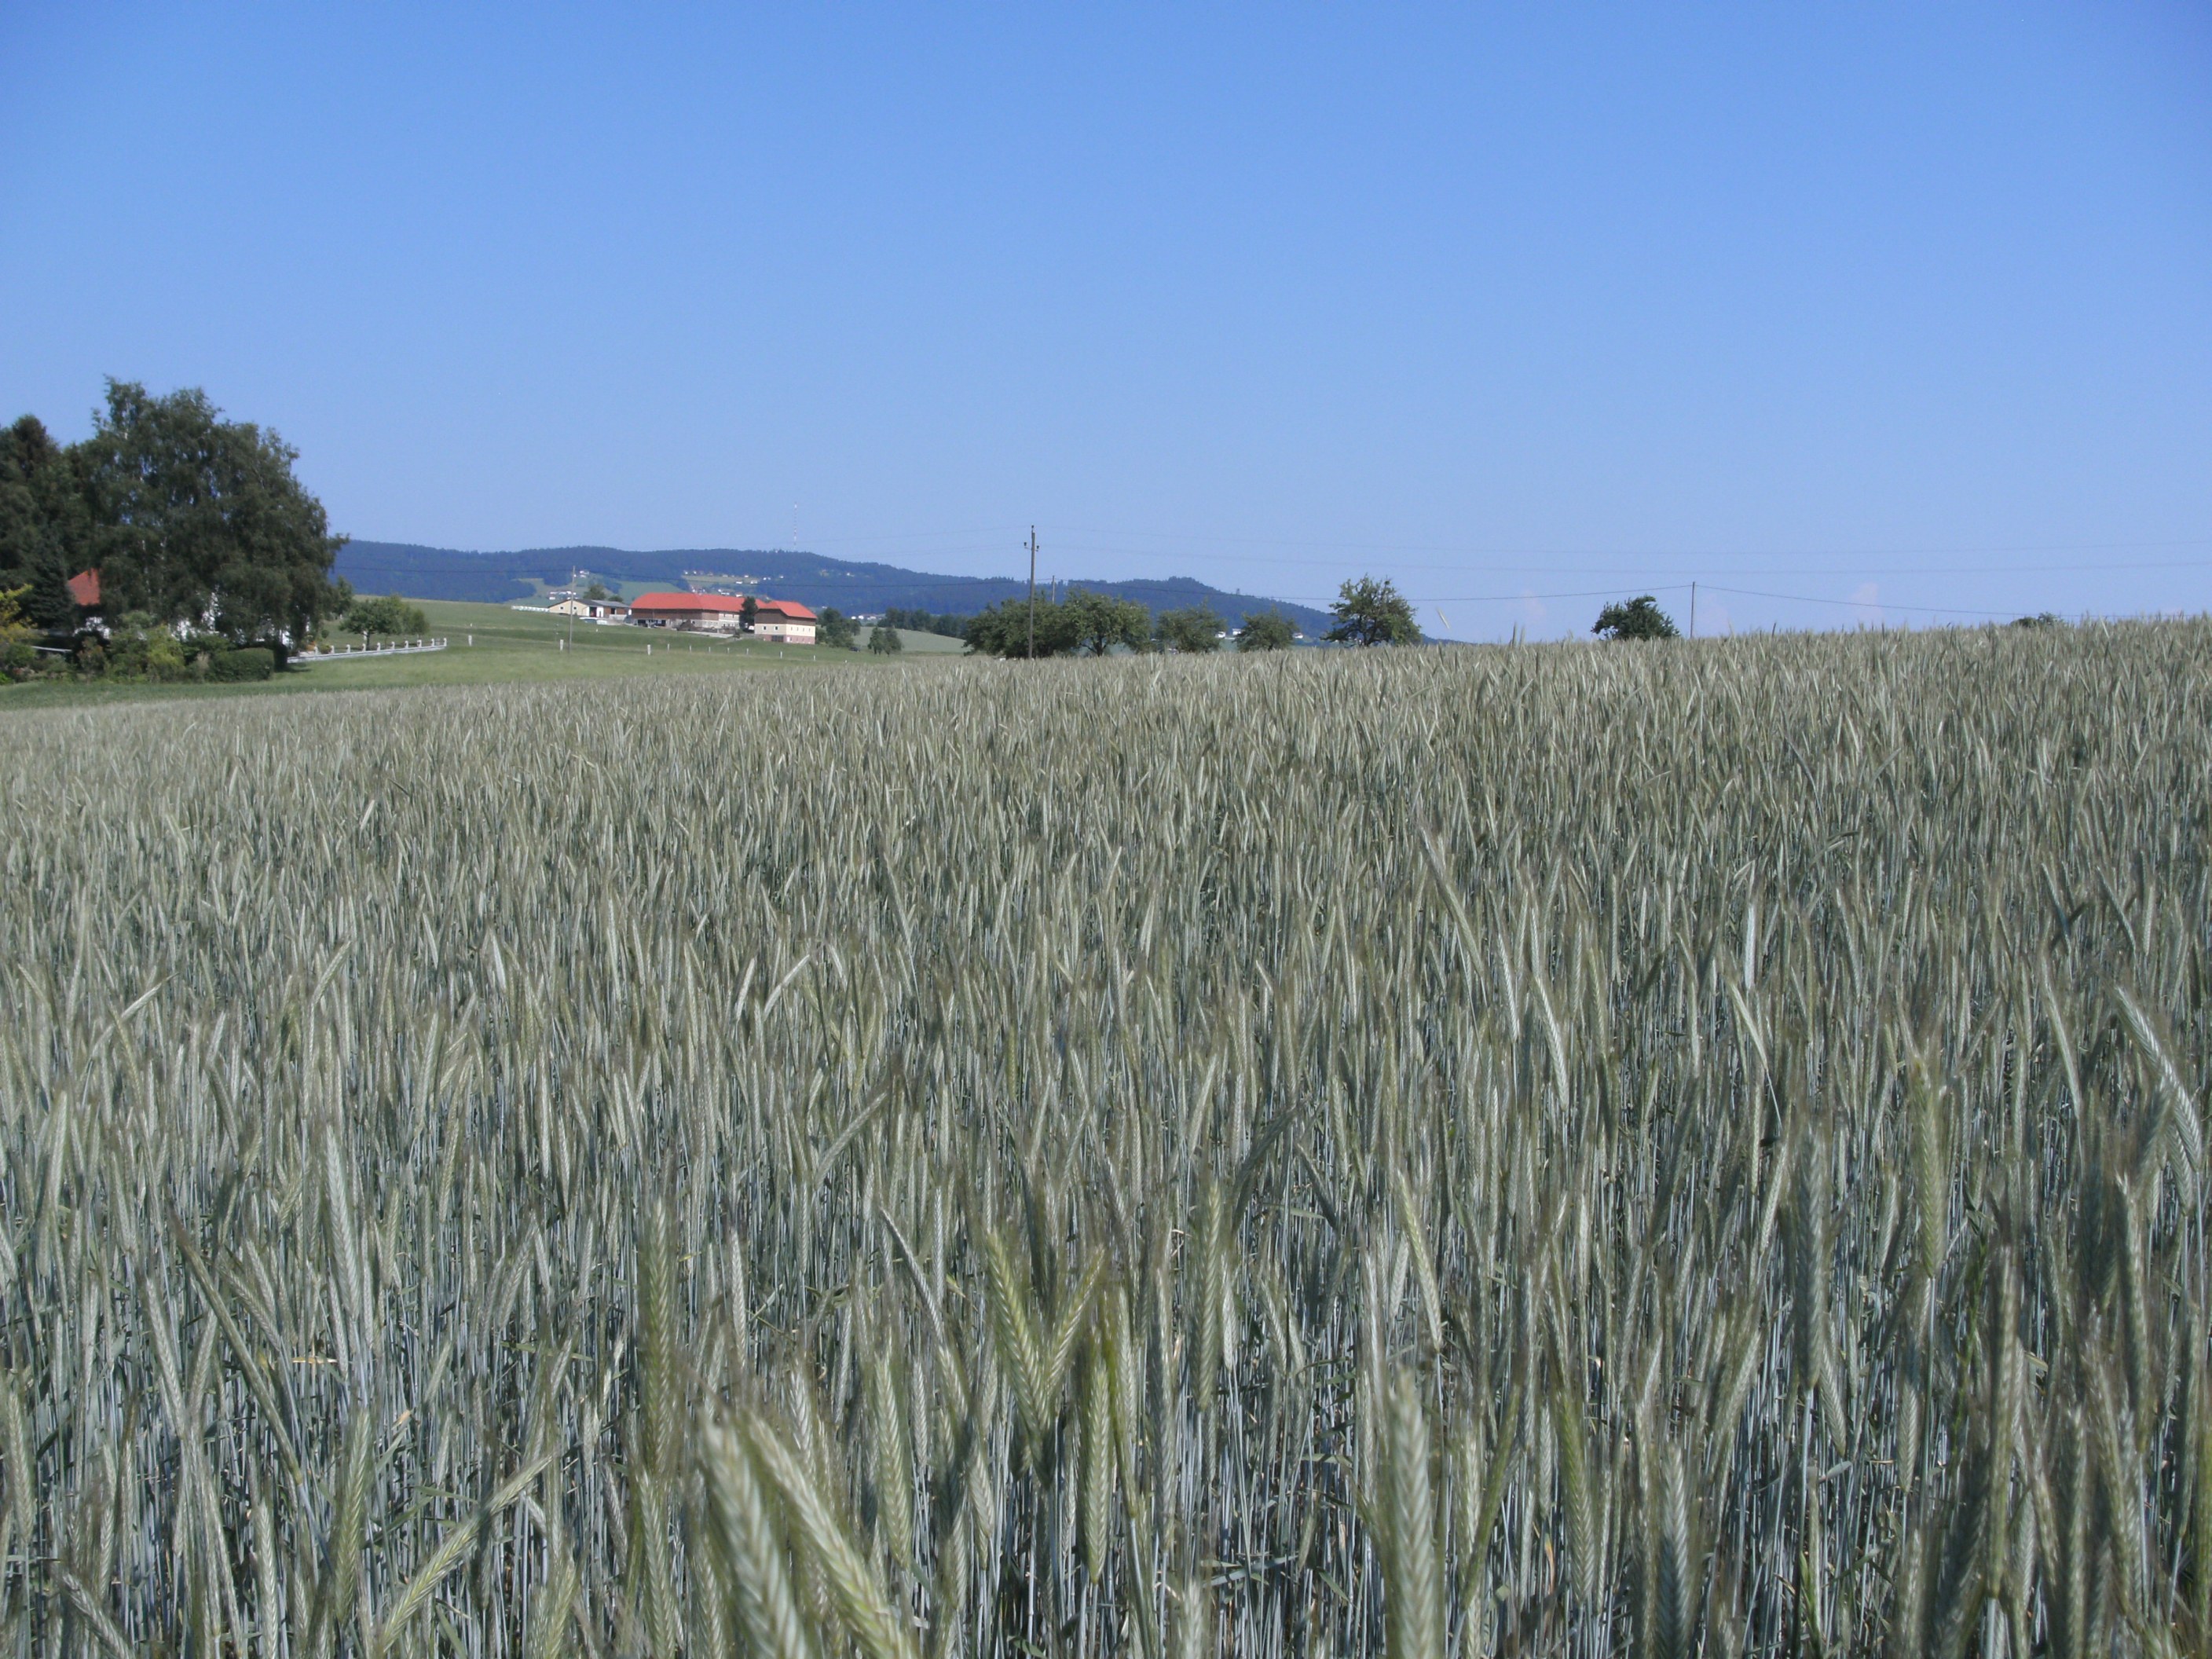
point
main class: Cropland
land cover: Rye
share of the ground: > 75 %
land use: Agriculture (excluding fallow land and kitchen gardens)
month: June
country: AT
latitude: 48.3968
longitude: 14.1736
